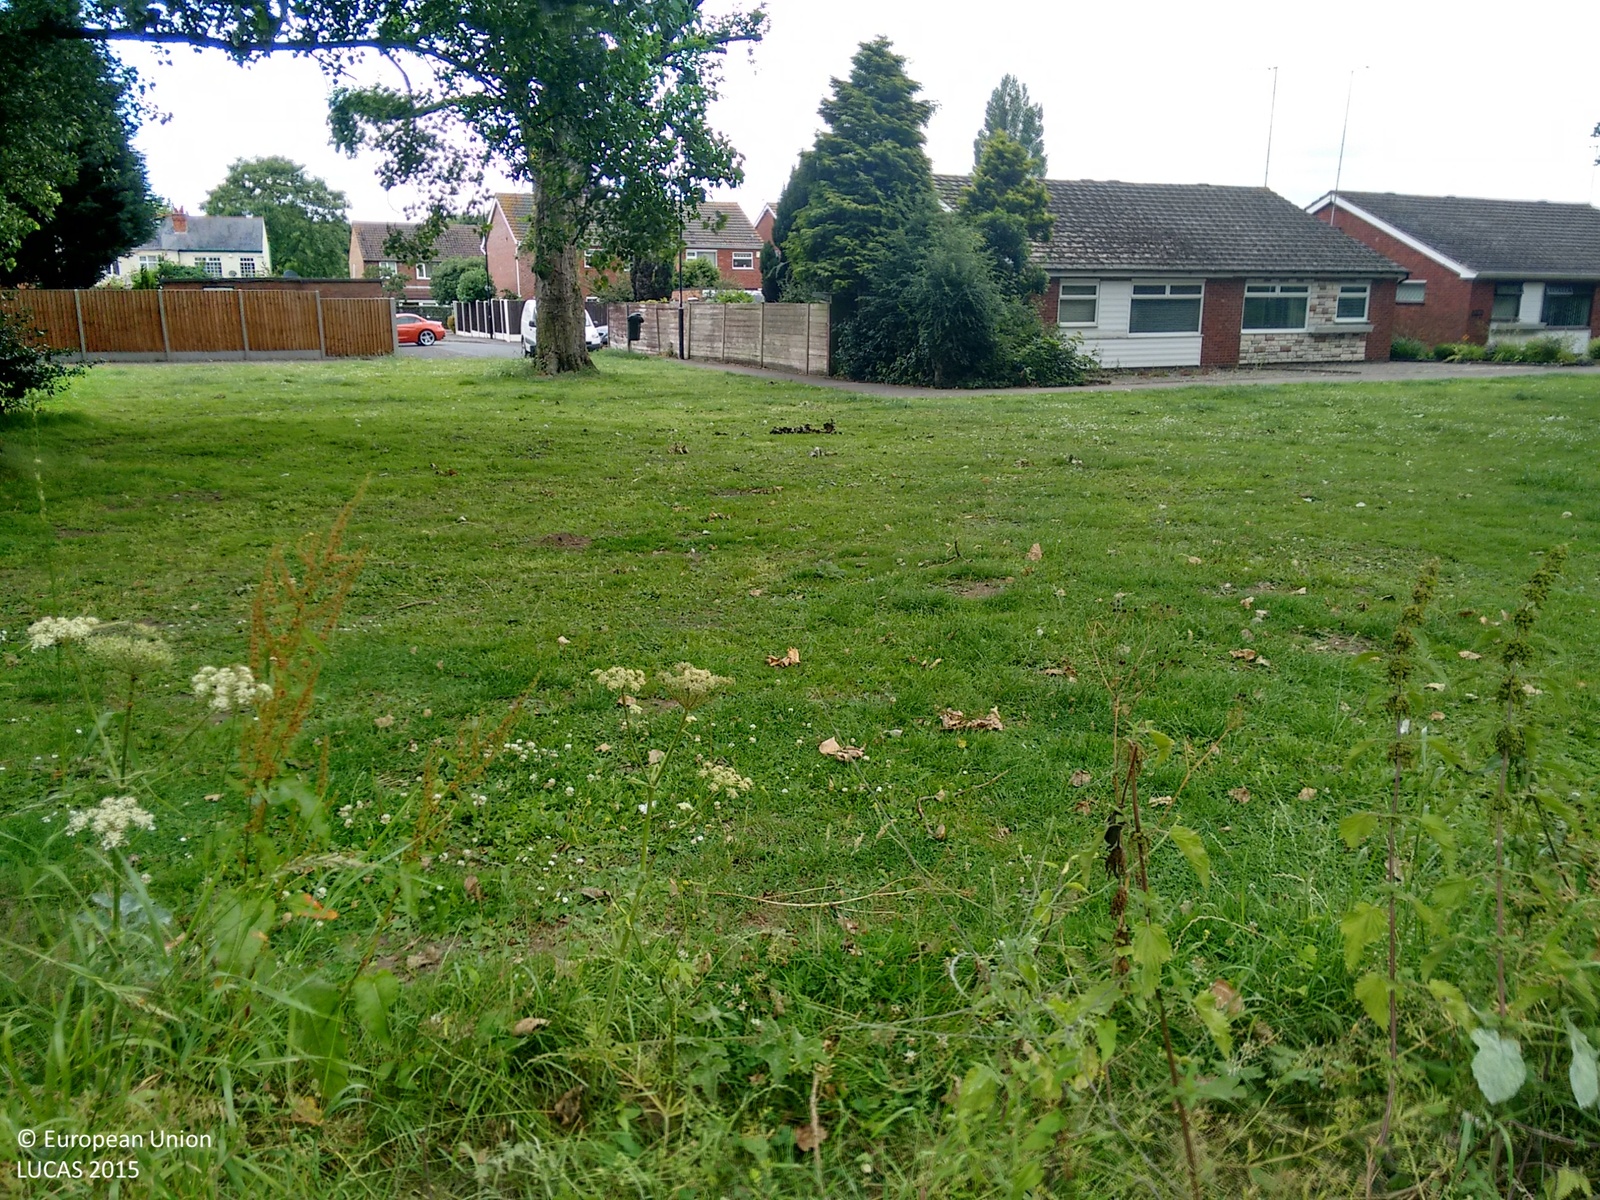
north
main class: Grassland
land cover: Grassland with sparse tree/shrub cover
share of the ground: > 75 %
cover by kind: herbaceous plants 90 %, broadleaved forest trees 5 %, shrubs 5 %
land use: Amenities, museums, leisure
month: July
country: GB
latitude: 52.4034
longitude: -1.4415
